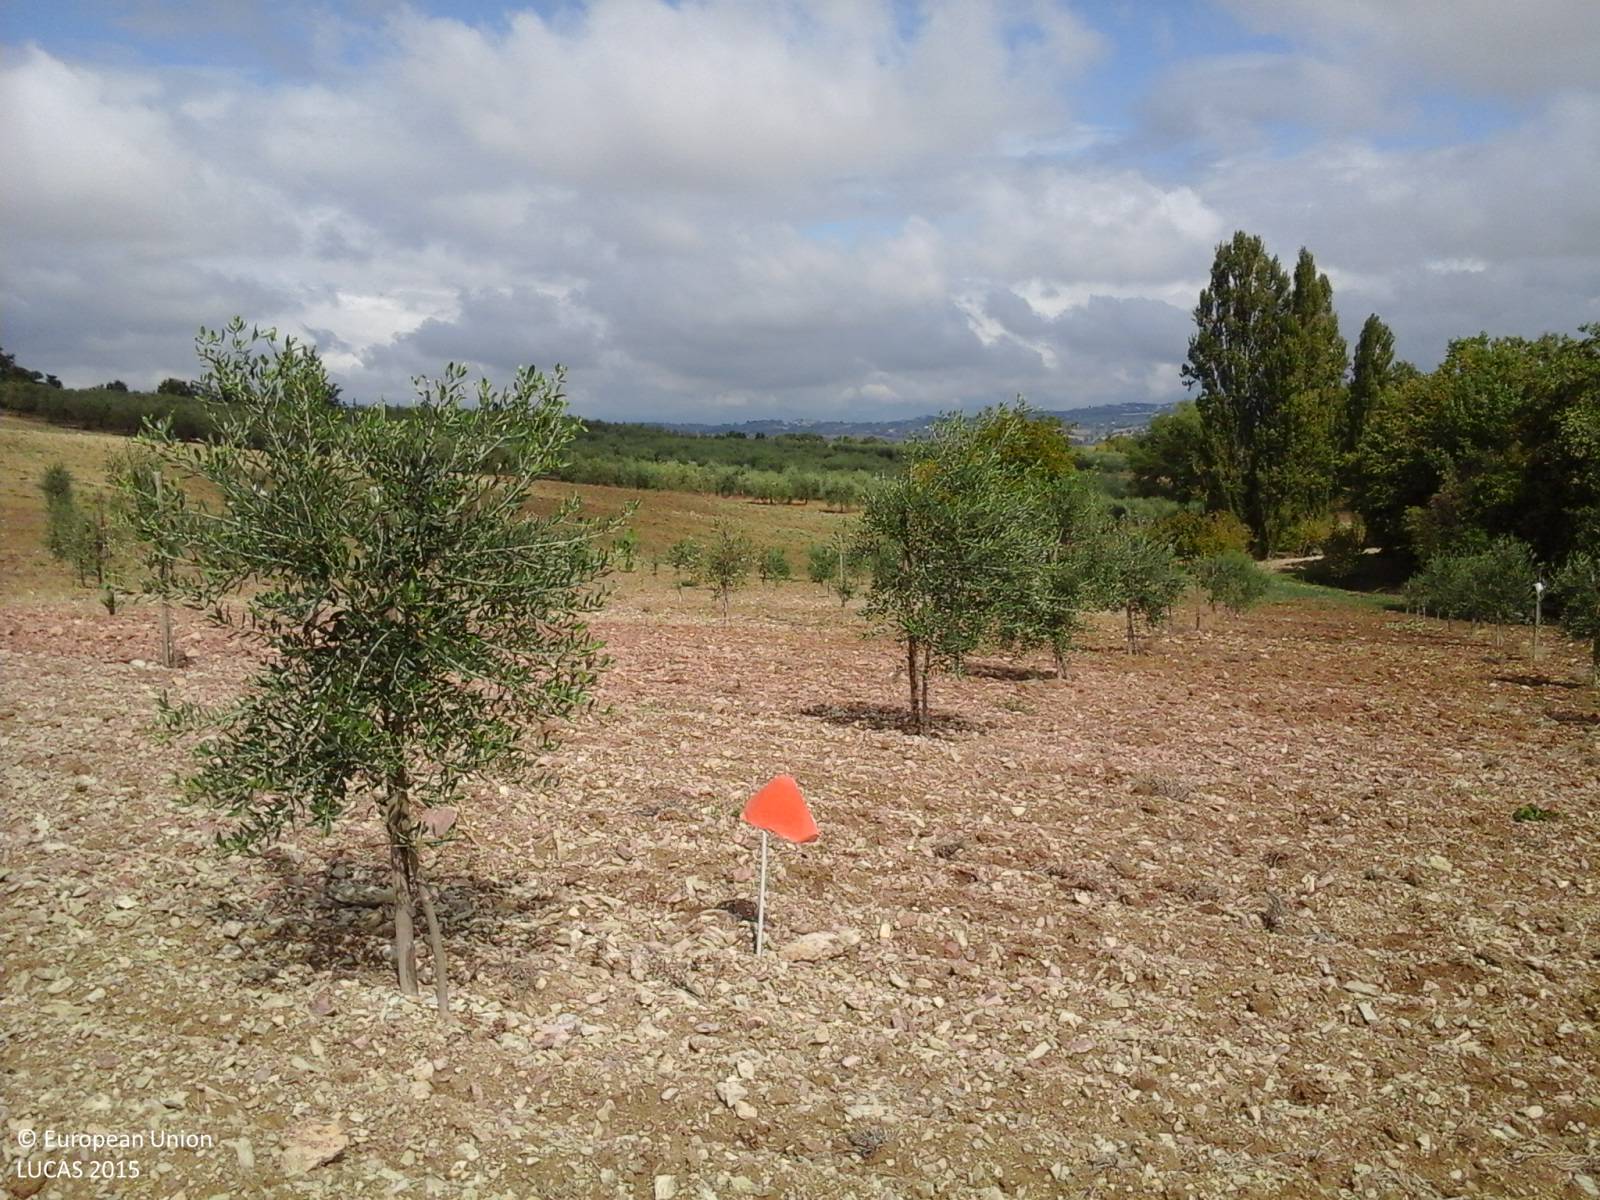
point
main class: Cropland
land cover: Olive groves
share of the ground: 10 - 25 %
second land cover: Other bare soil
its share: > 75 %
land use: Agriculture (excluding fallow land and kitchen gardens)
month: September
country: IT
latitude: 42.8375
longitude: 12.5981
